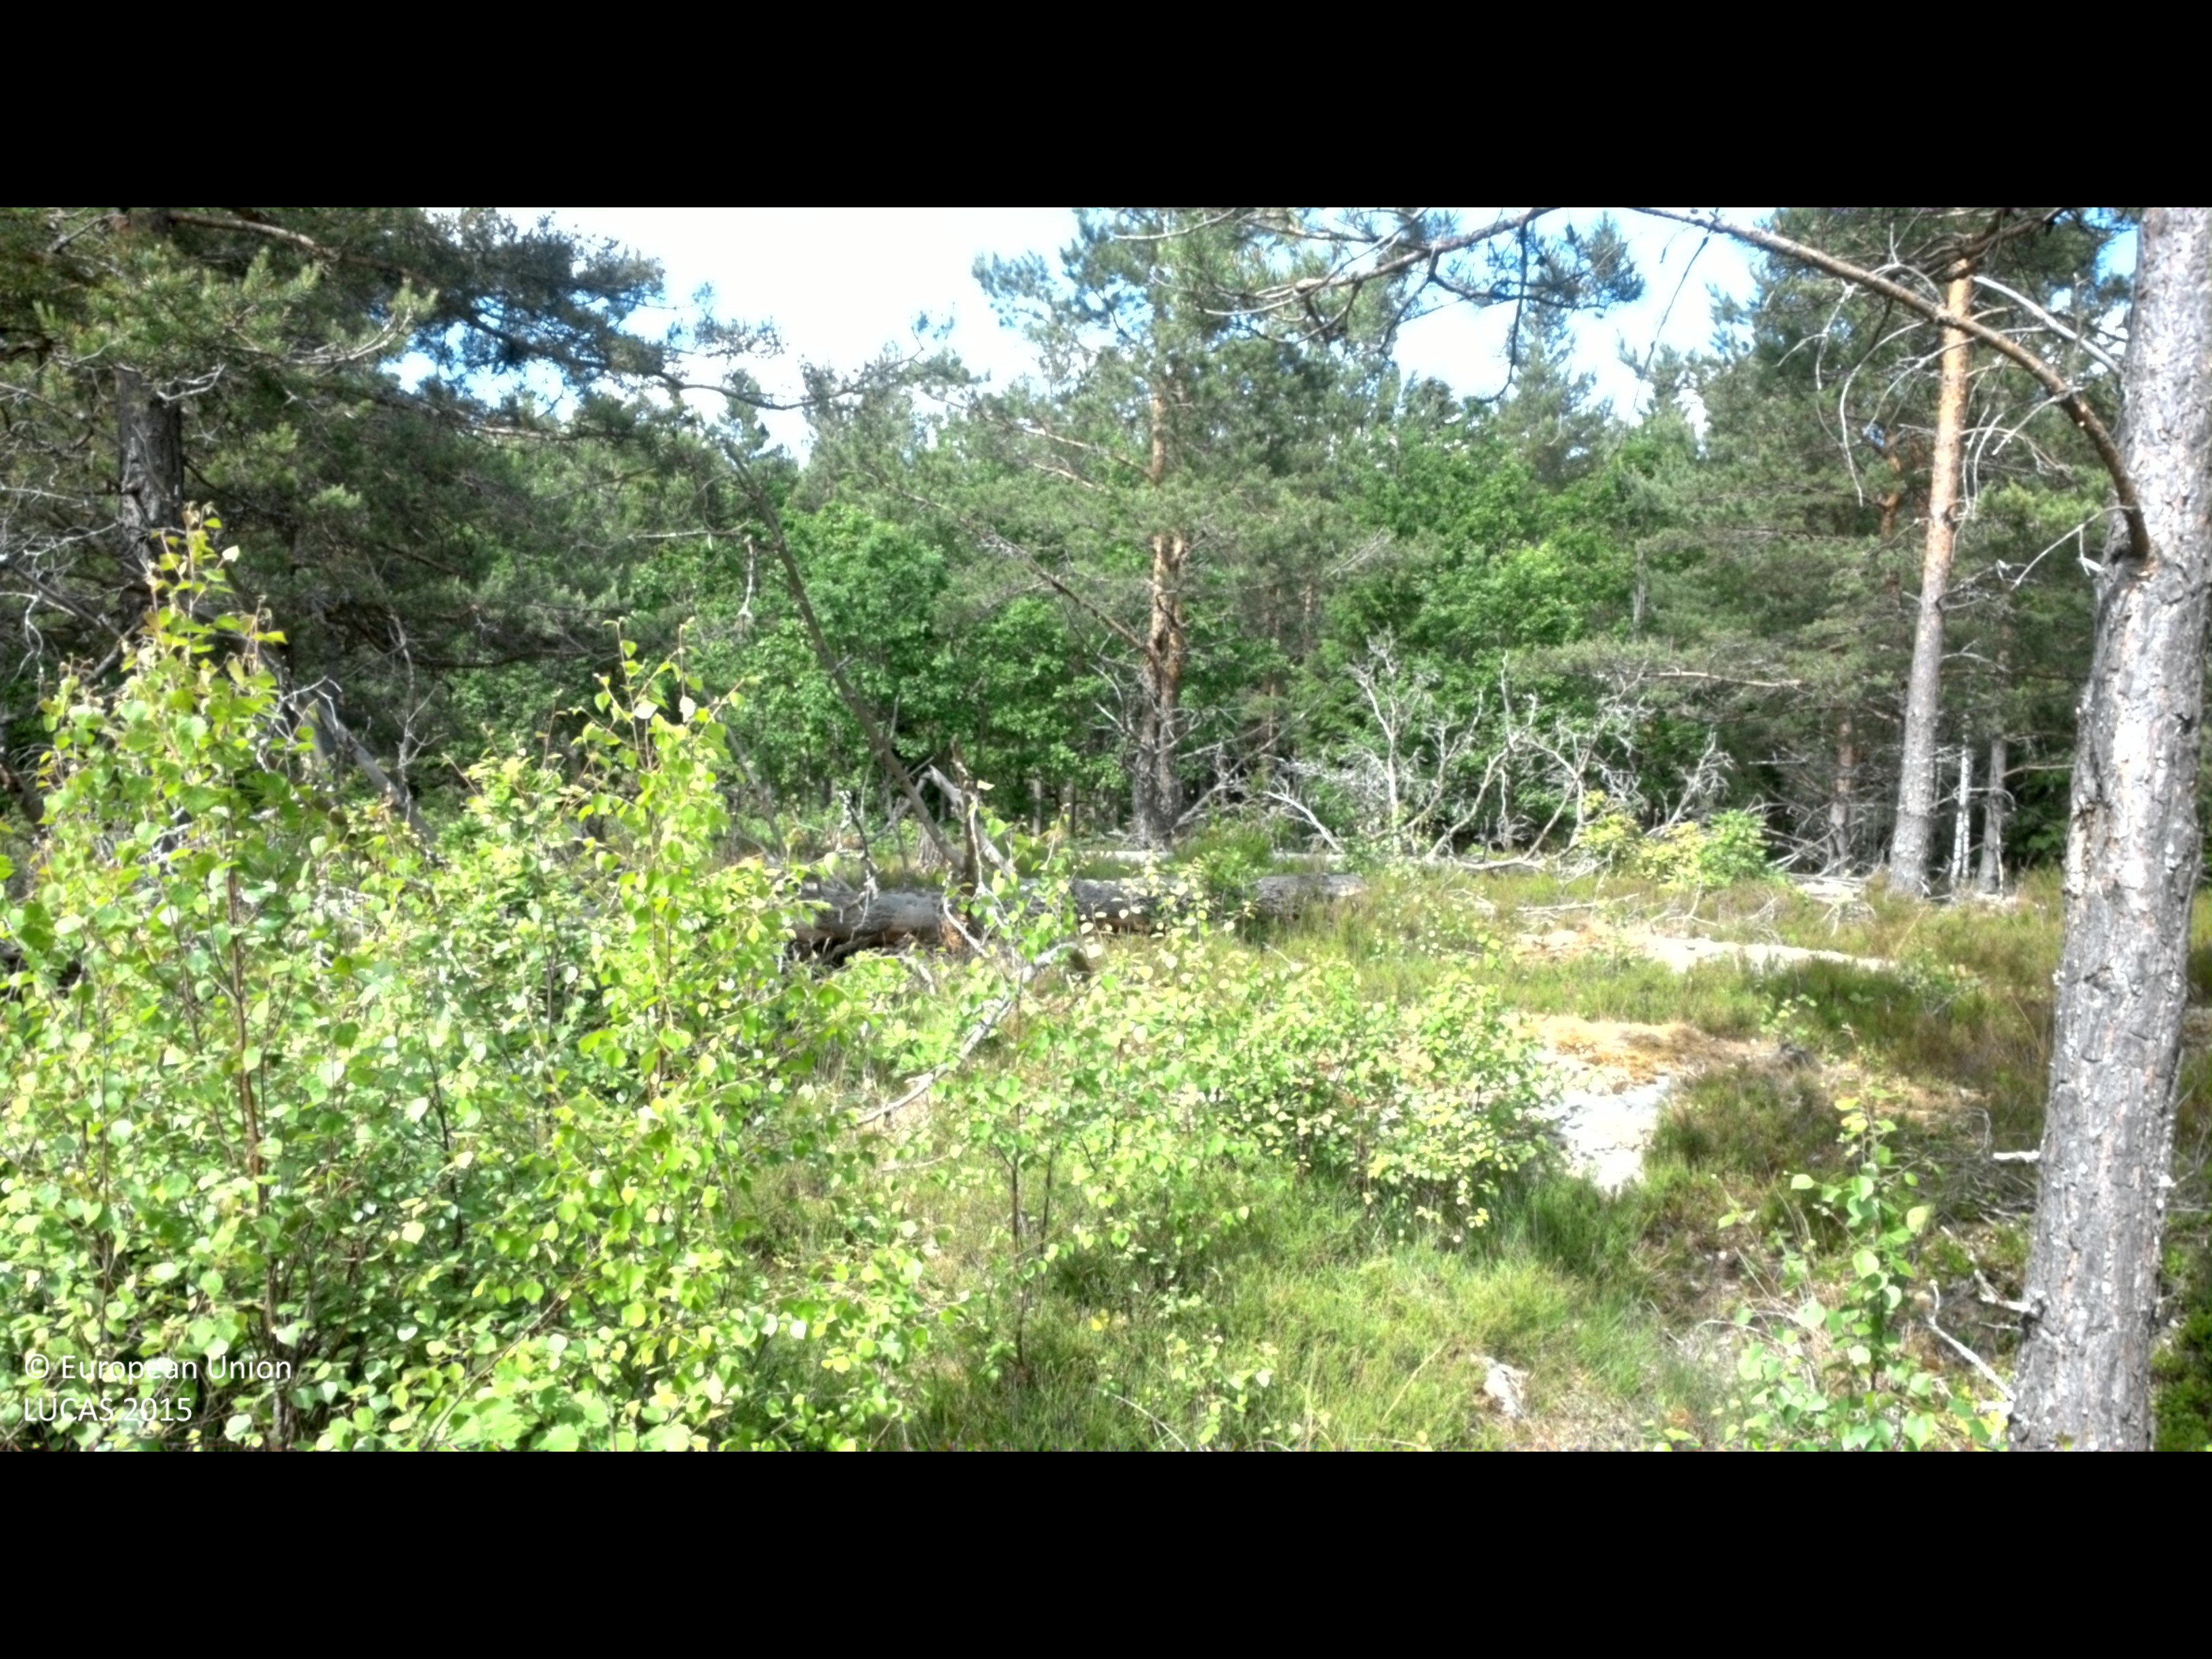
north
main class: Woodland
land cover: Other mixed woodland
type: boreal forest
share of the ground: 50 - 75 %
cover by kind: broadleaved forest trees 35 %, coniferous forest trees 30 %, shrubs 20 %, lichens and mosses 10 %, consolidated bare surface 5 %
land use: Forestry
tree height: > 5 m
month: June
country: SE
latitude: 57.7112
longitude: 16.6624
